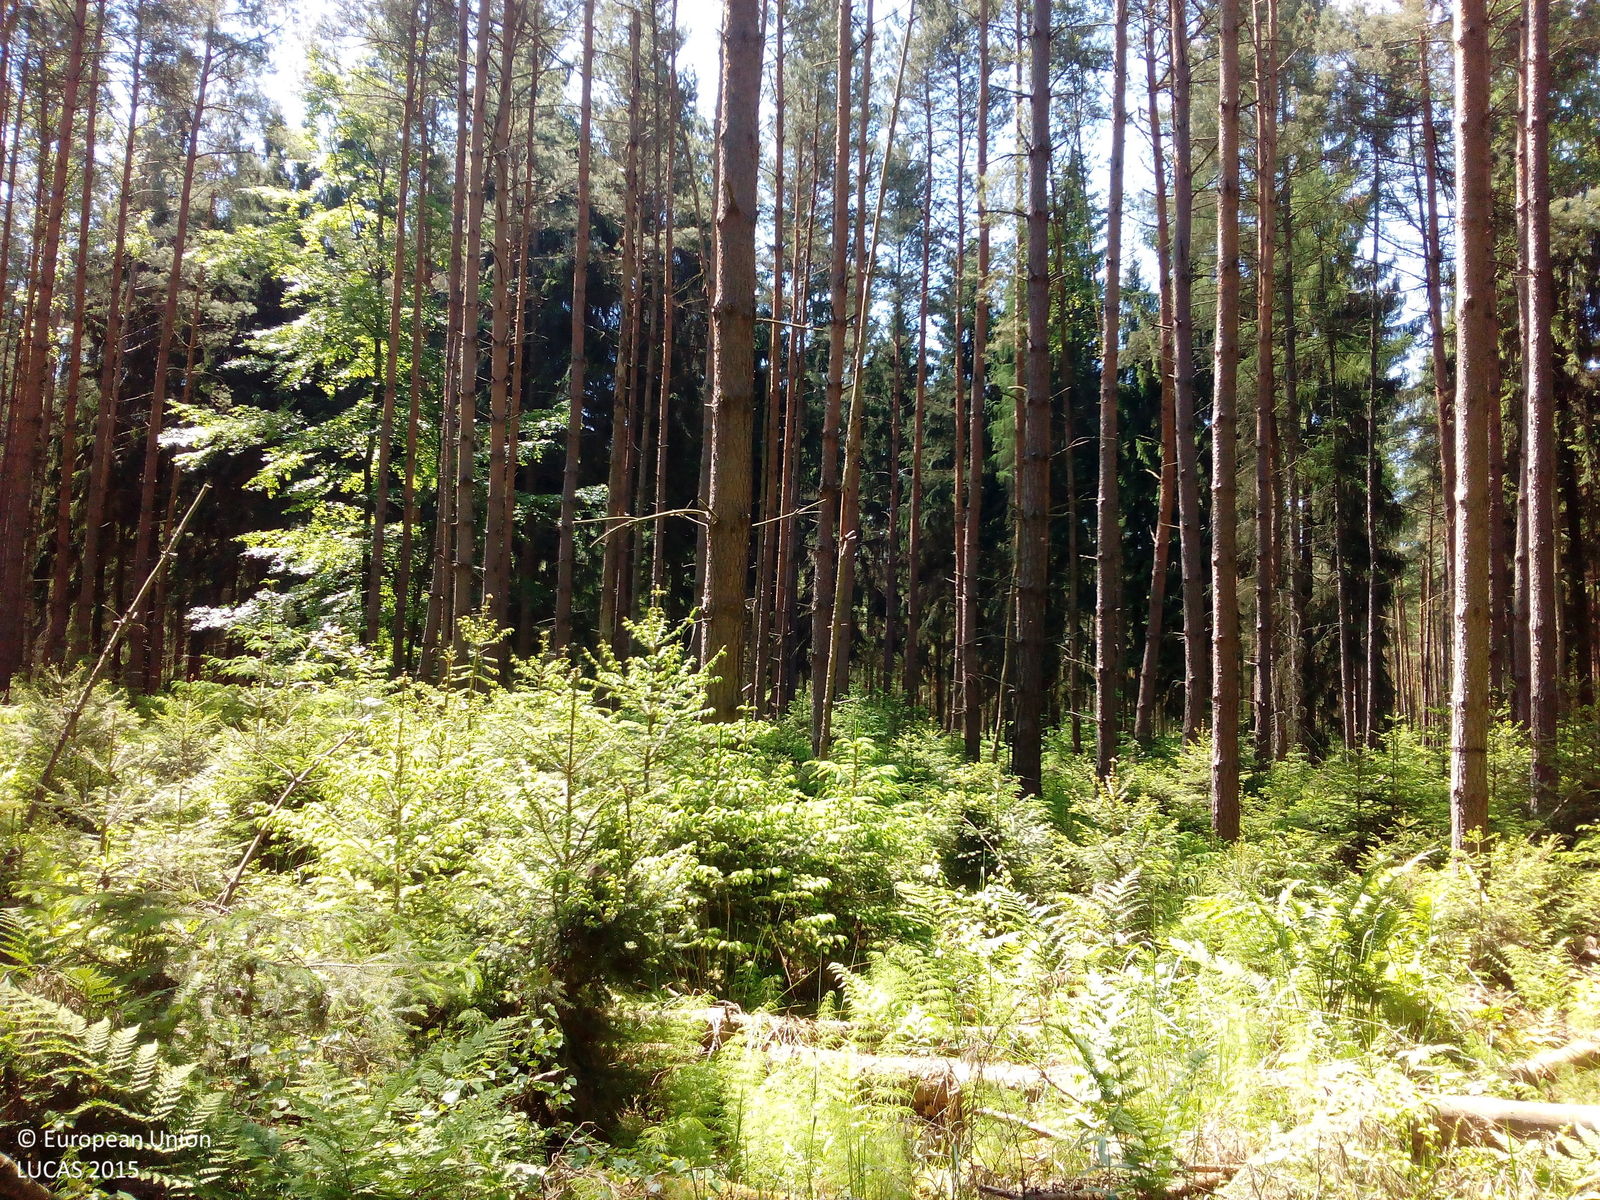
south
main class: Woodland
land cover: Other coniferous woodland
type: hemiboreal forest and nemoral coniferous forest and mixed broadleaved-coniferous forest
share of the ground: > 75 %
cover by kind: coniferous forest trees 70 %, herbaceous plants 20 %, broadleaved forest trees 10 %
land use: Forestry
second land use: Amenities, museums, leisure
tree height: > 5 m
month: June
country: DE
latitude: 50.7657
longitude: 11.6585
